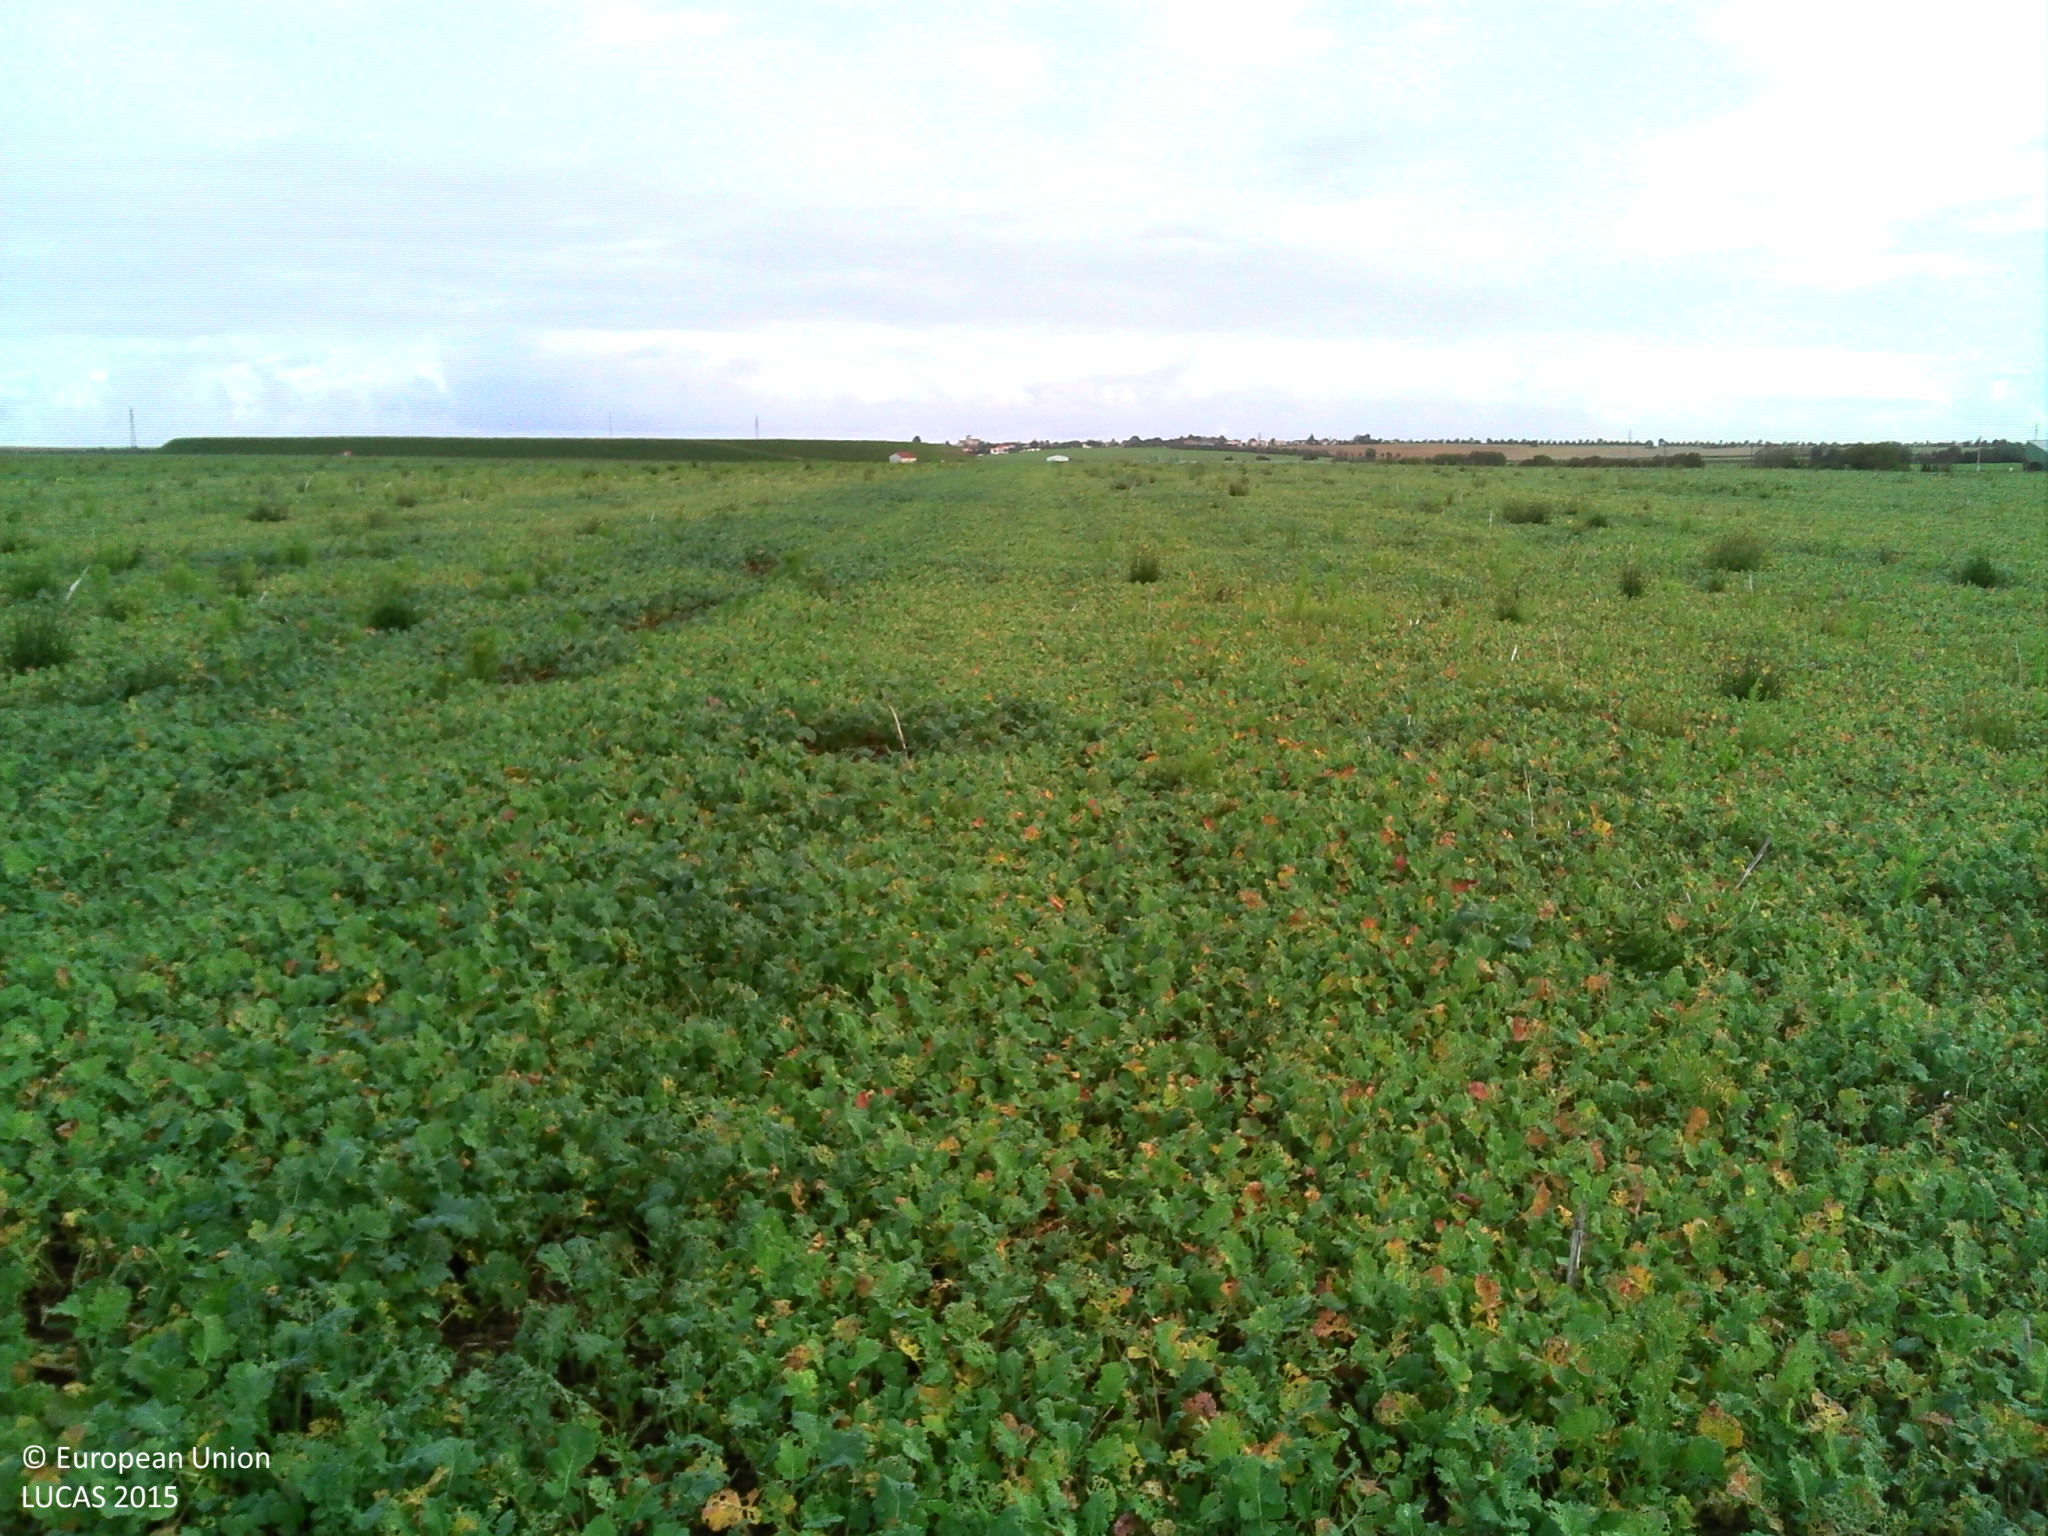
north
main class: Cropland
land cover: Rape and turnip rape
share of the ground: 50 - 75 %
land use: Agriculture (excluding fallow land and kitchen gardens)
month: October
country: FR
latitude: 46.4839
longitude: -1.0659
